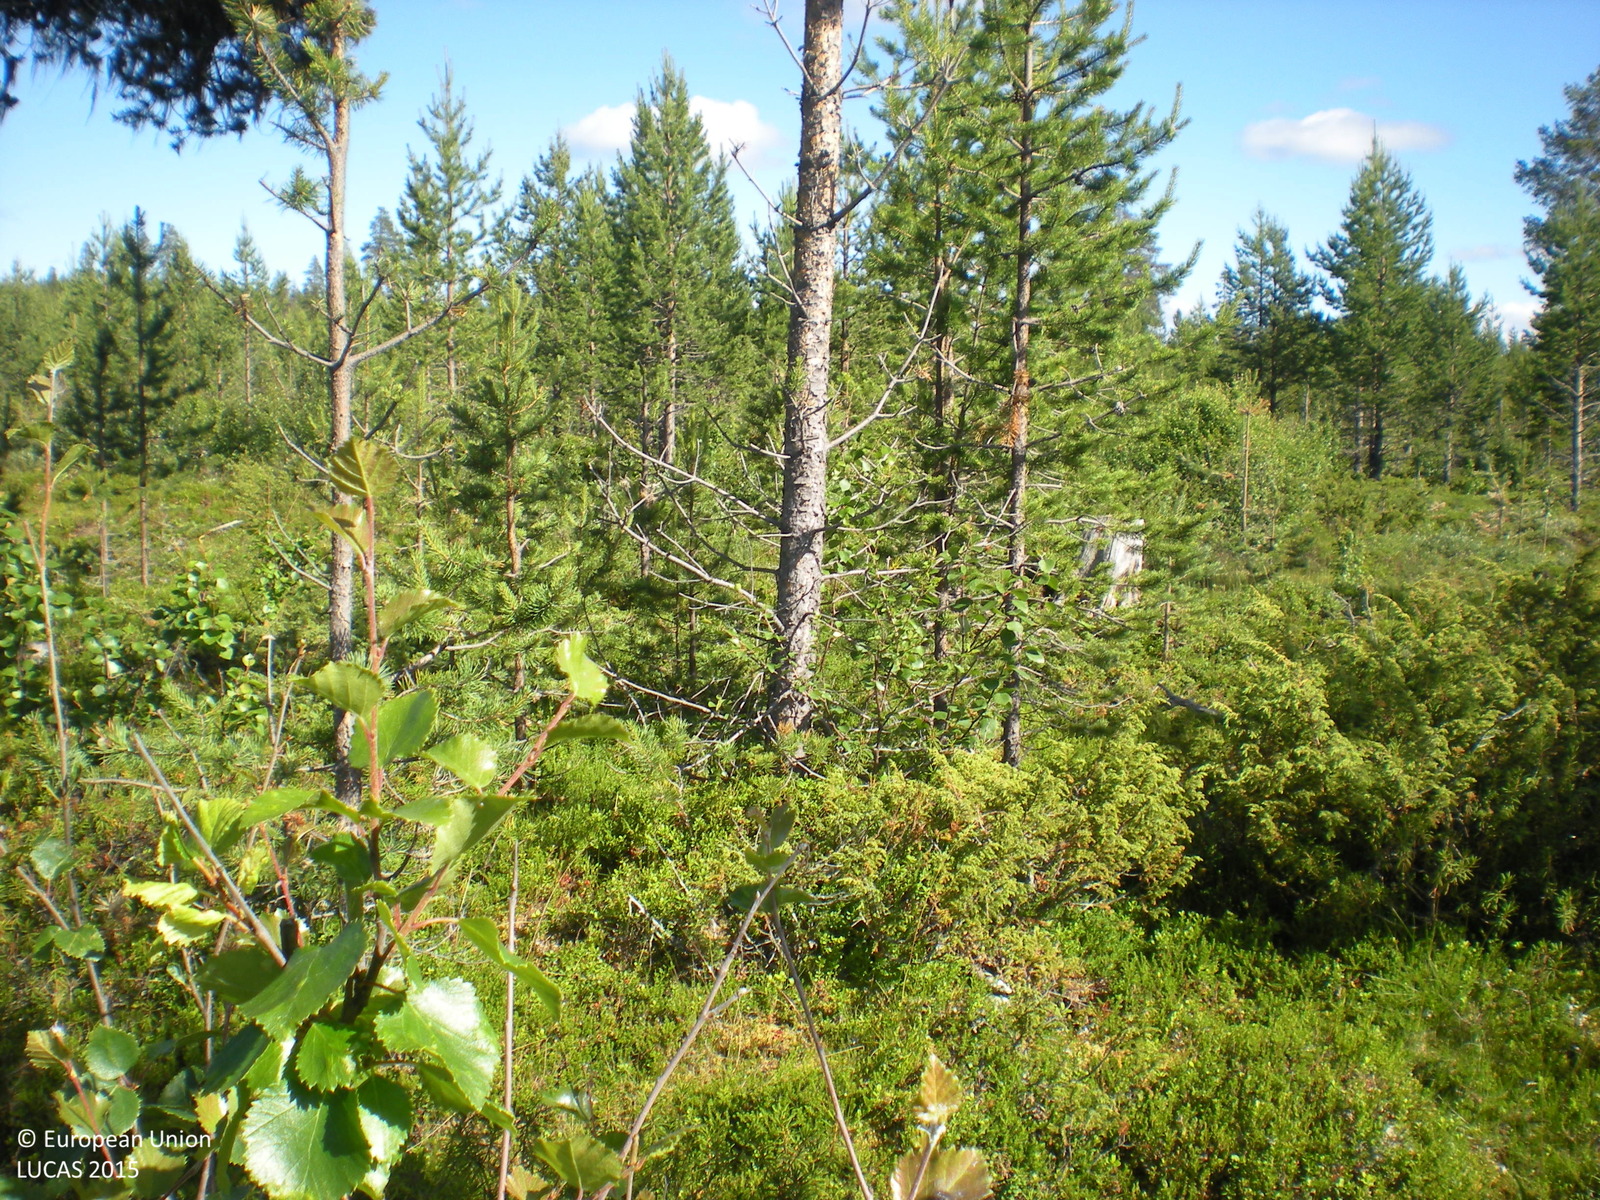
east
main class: Woodland
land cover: Pine dominated mixed woodland
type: boreal forest
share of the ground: 25 - 50 %
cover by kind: shrubs 50 %, coniferous forest trees 20 %, broadleaved forest trees 15 %, lichens and mosses 10 %, herbaceous plants 5 %
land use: Forestry
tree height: < 5 m
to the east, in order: Pine dominated mixed woodland; Ponds and wetlands; Pine dominated mixed woodland; Ponds and wetlands; Pine dominated mixed woodland
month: August
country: SE
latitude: 66.4128
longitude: 18.0369
